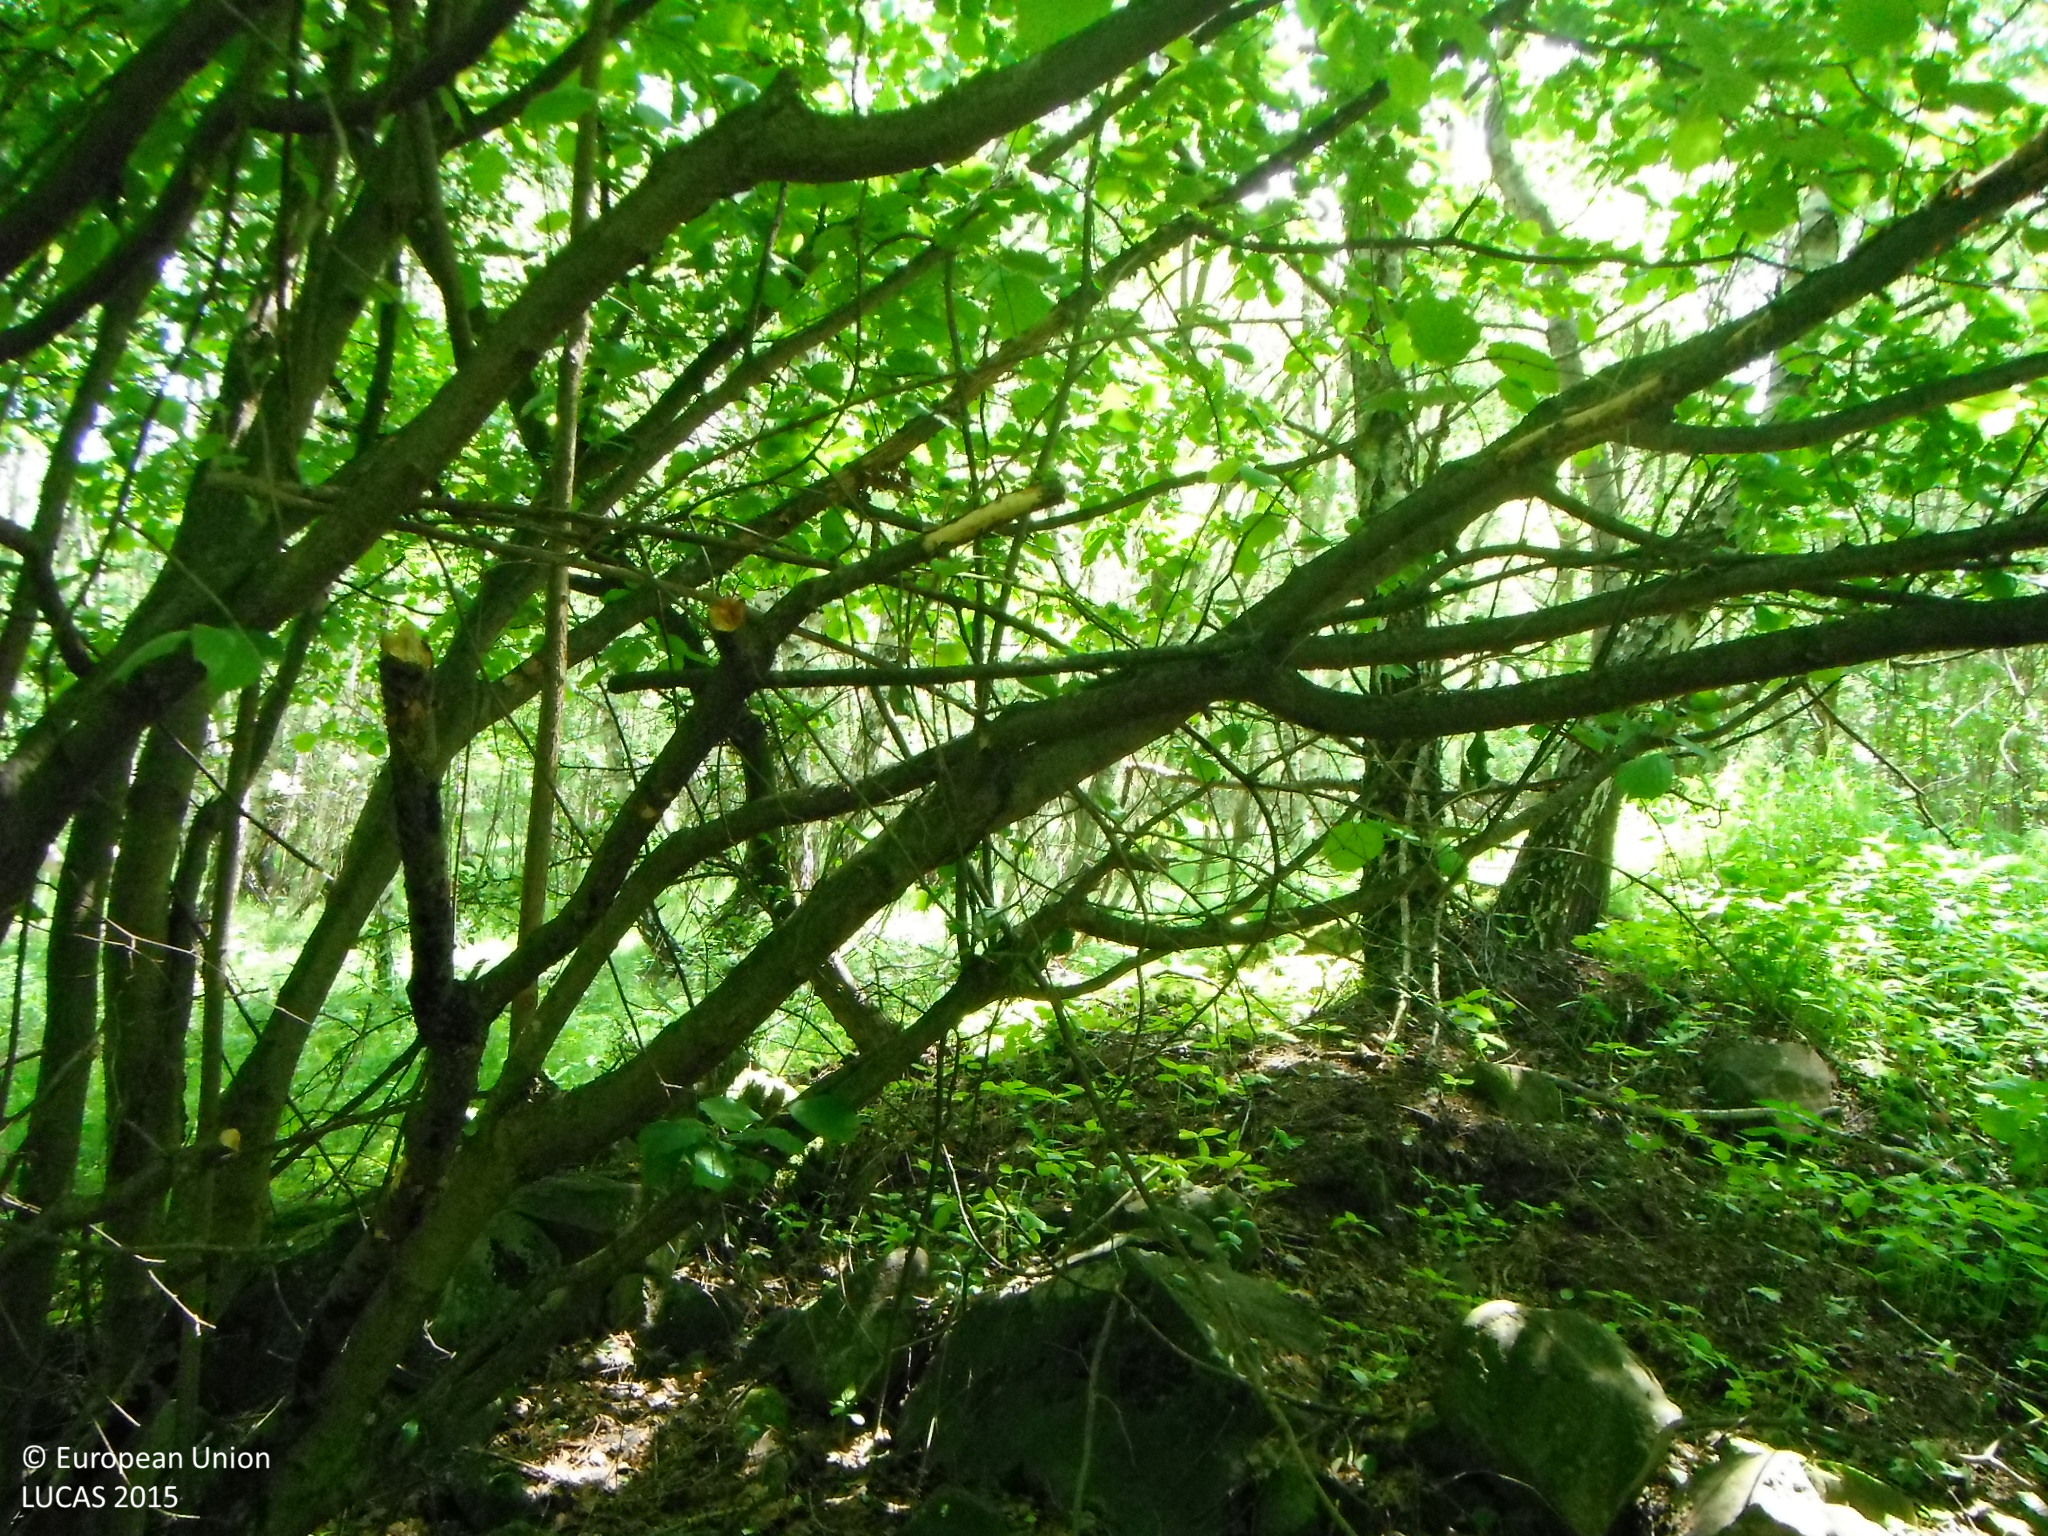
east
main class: Woodland
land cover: Broadleaved woodland
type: acidophilous oak and oak-birch forest
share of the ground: > 75 %
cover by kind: broadleaved forest trees 100 %
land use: Forestry
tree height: > 5 m
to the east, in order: Broadleaved woodland; Tracks; Broadleaved woodland; Tracks; Other mixed woodland; Broadleaved woodland; Other mixed woodland
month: May
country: SK
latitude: 48.4334
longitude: 19.0086
